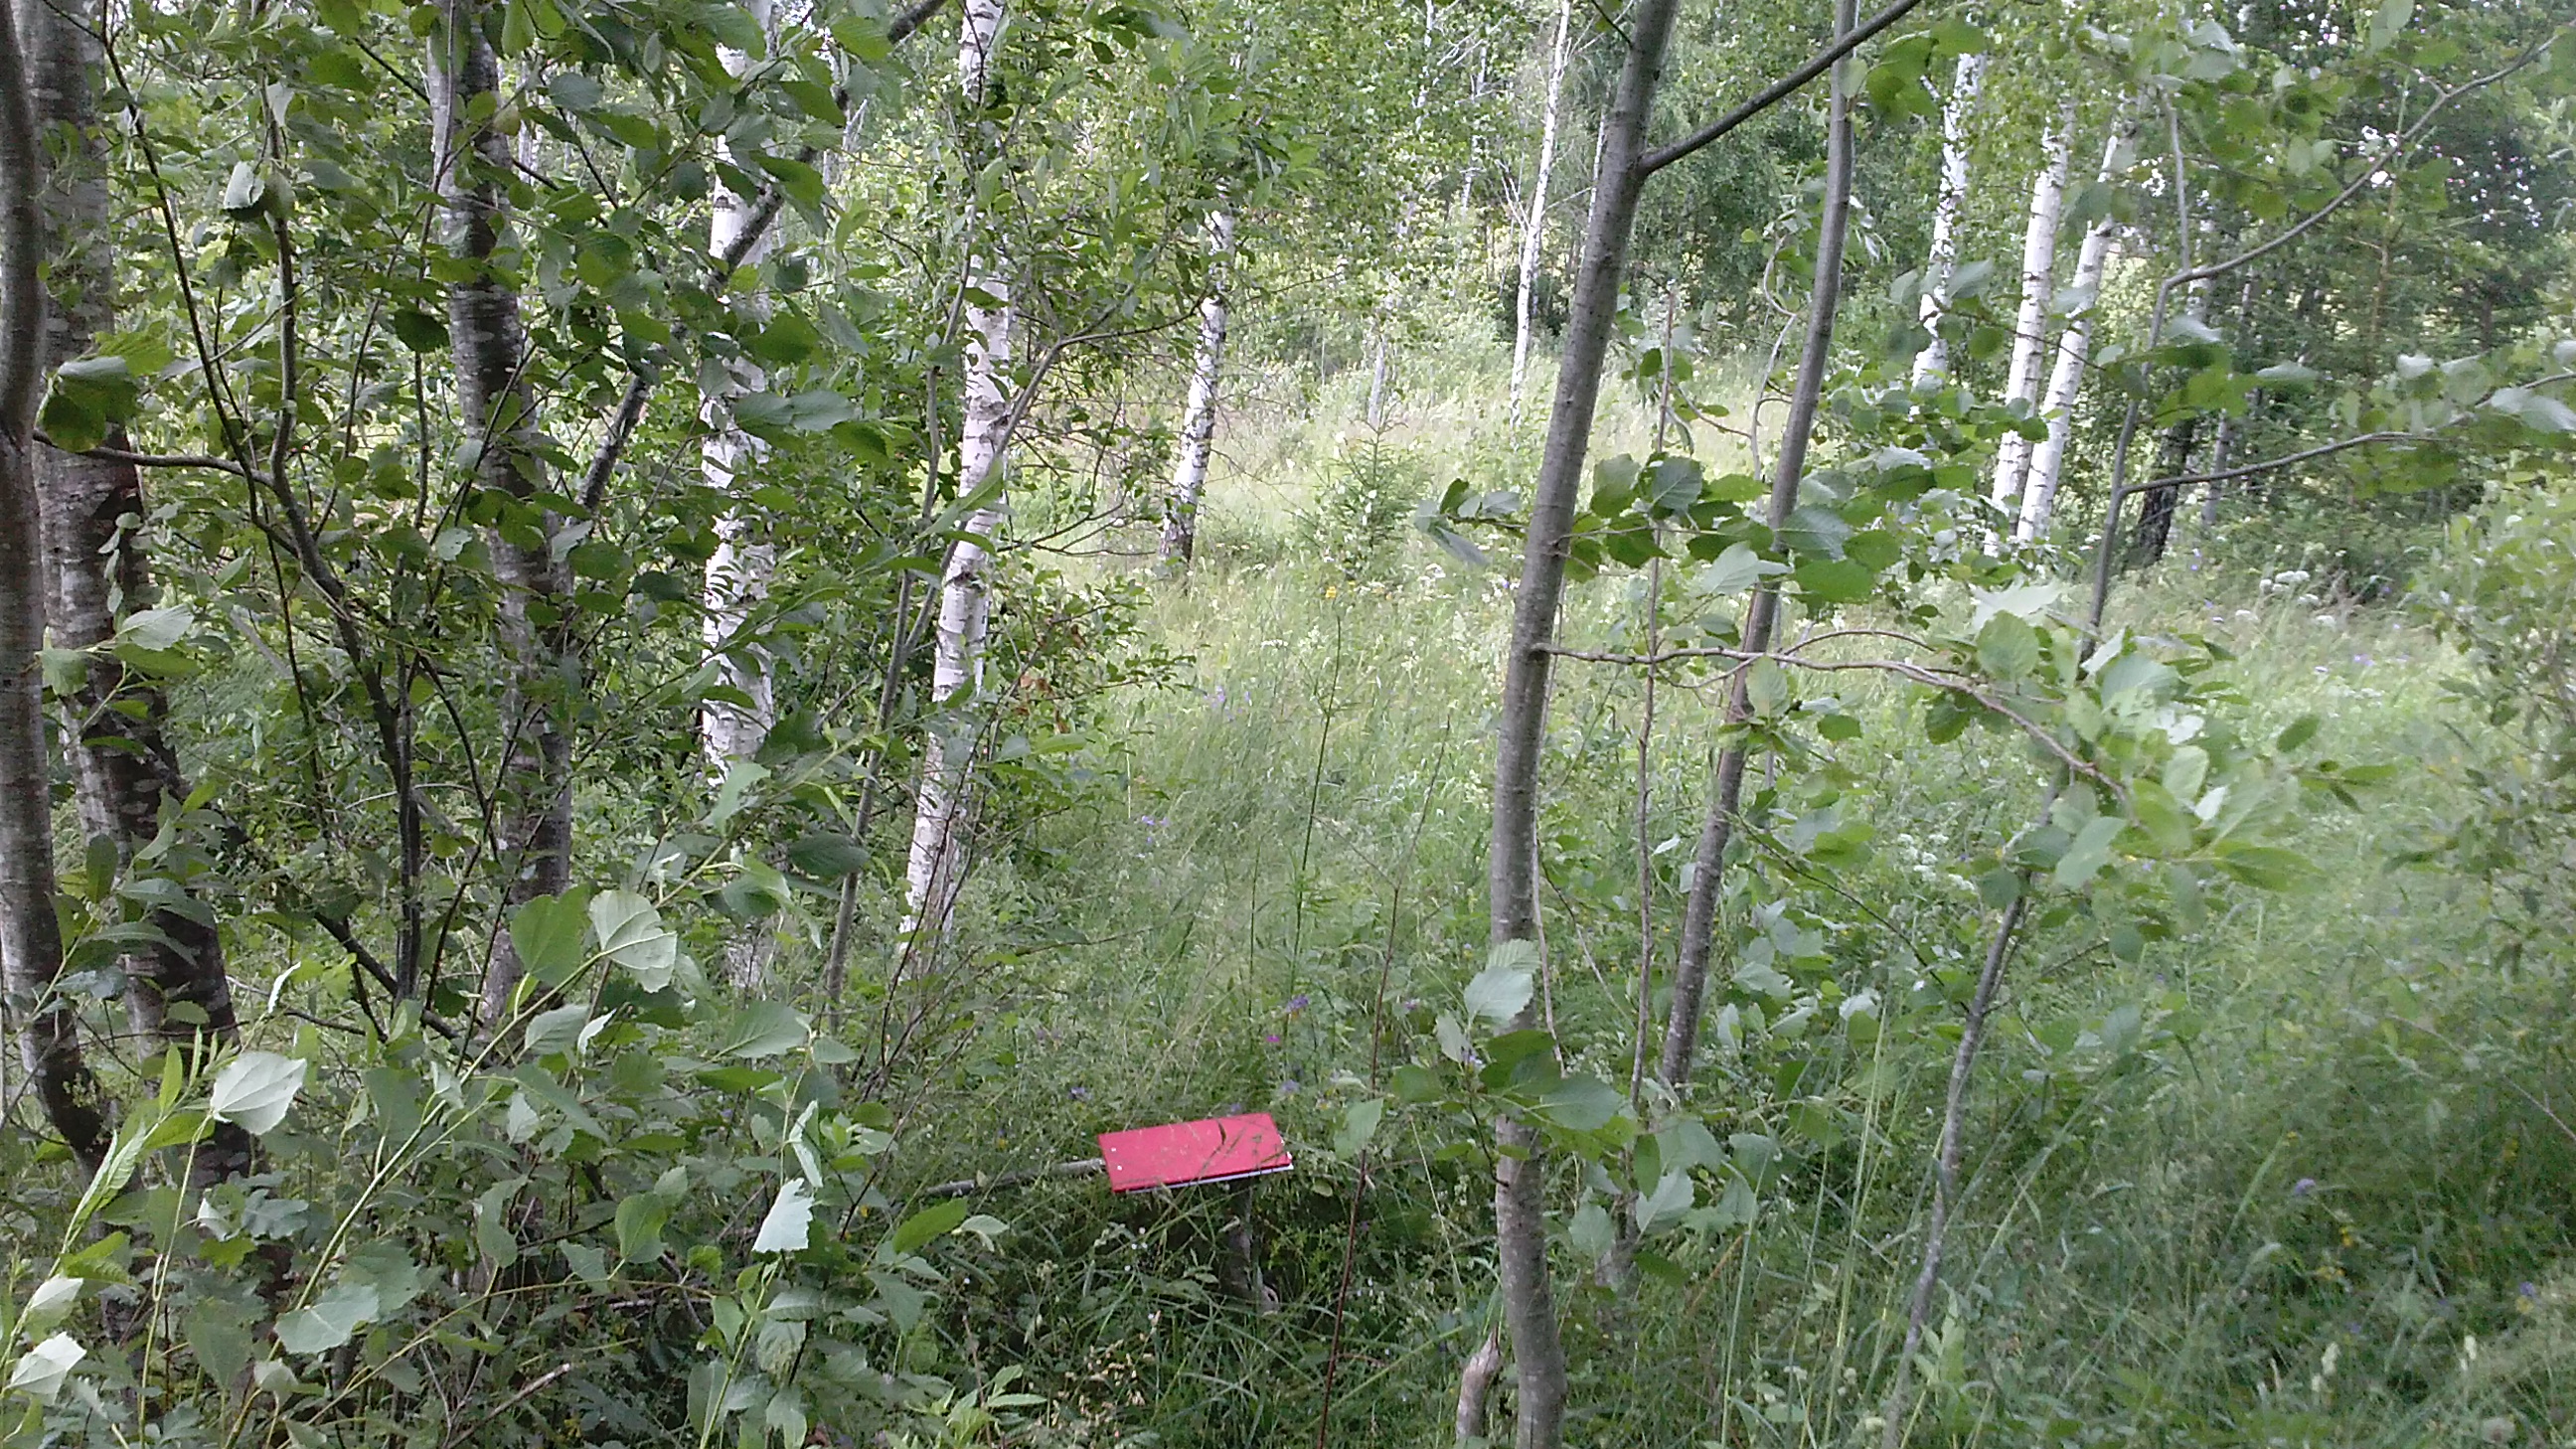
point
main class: Woodland
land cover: Broadleaved woodland
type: non-riverine alder, birch or aspen forest
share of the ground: 50 - 75 %
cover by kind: broadleaved forest trees 65 %, herbaceous plants 30 %, coniferous forest trees 5 %
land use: Forestry
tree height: > 5 m
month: July
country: LV
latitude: 56.5614
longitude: 27.4749
